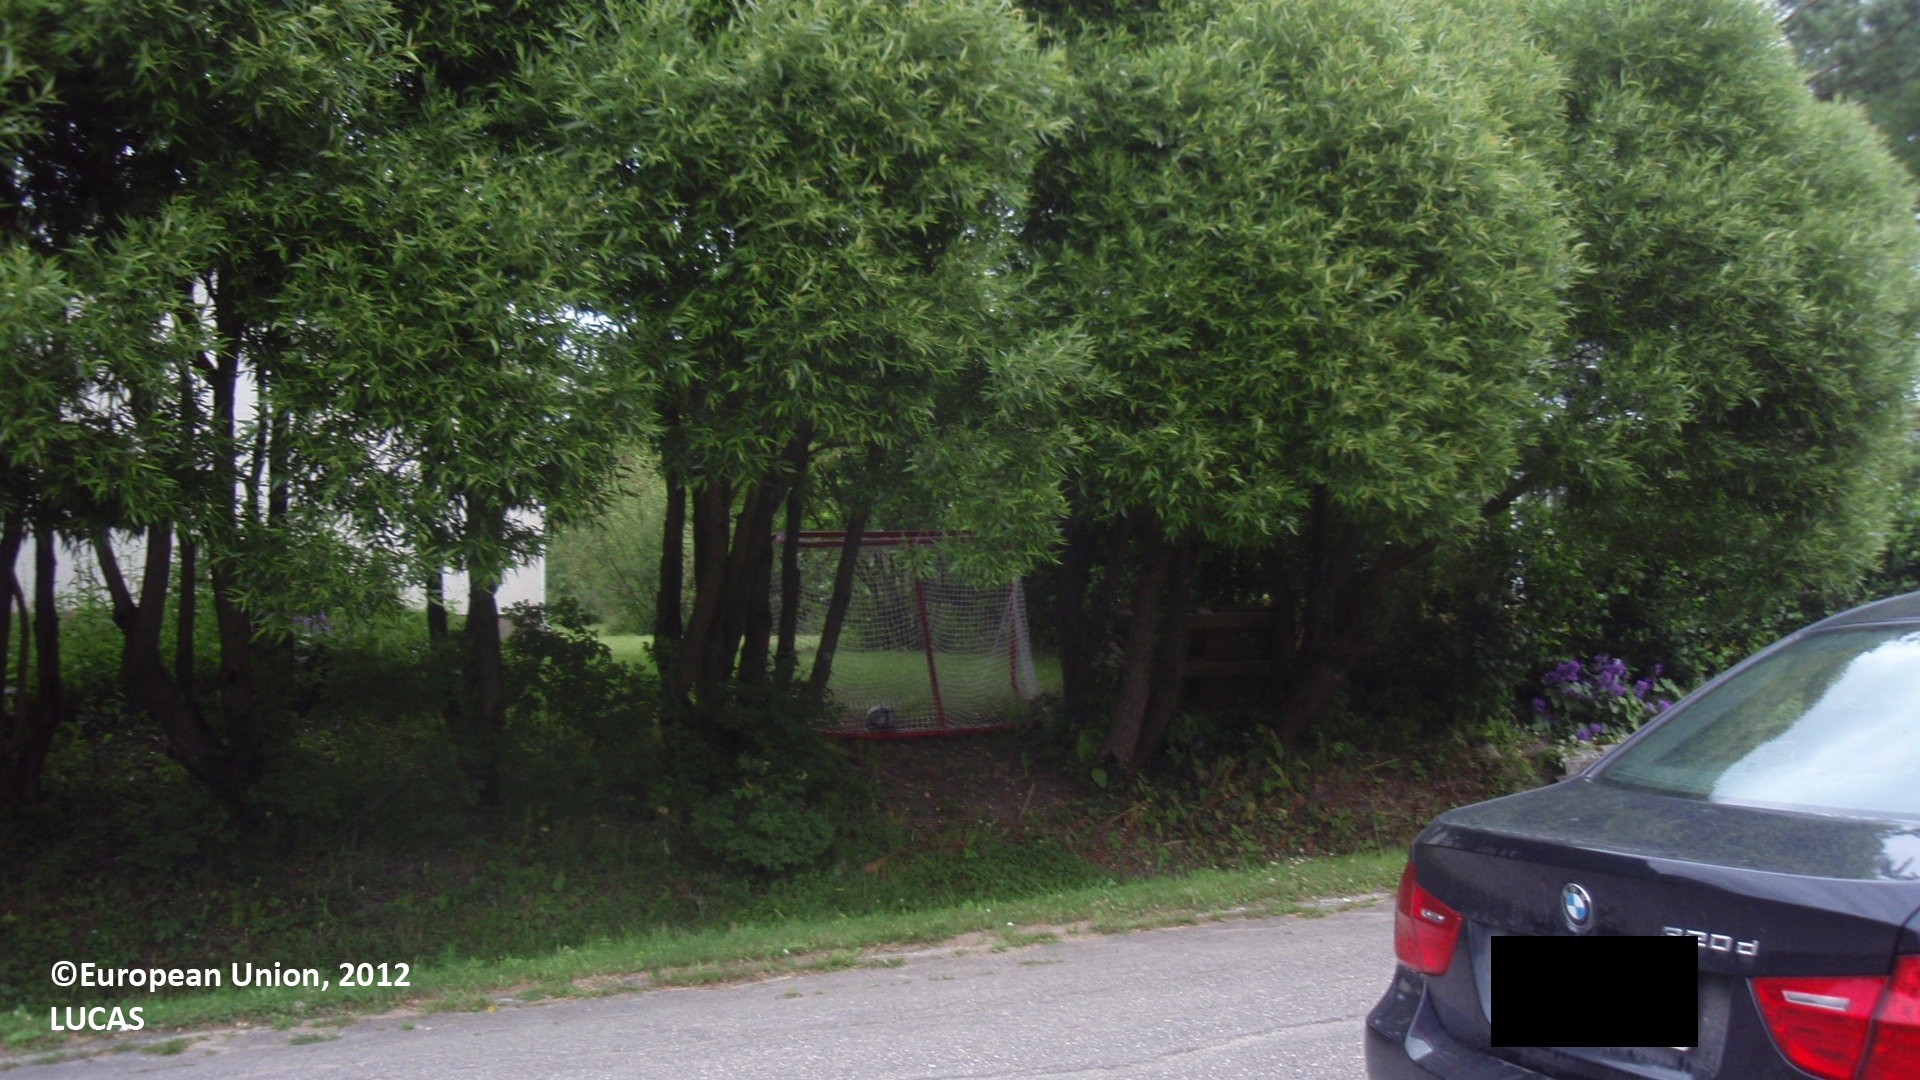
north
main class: Grassland
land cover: Grassland with sparse tree/shrub cover
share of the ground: > 75 %
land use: Residential
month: July
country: FI
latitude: 61.1552
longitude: 28.7504
